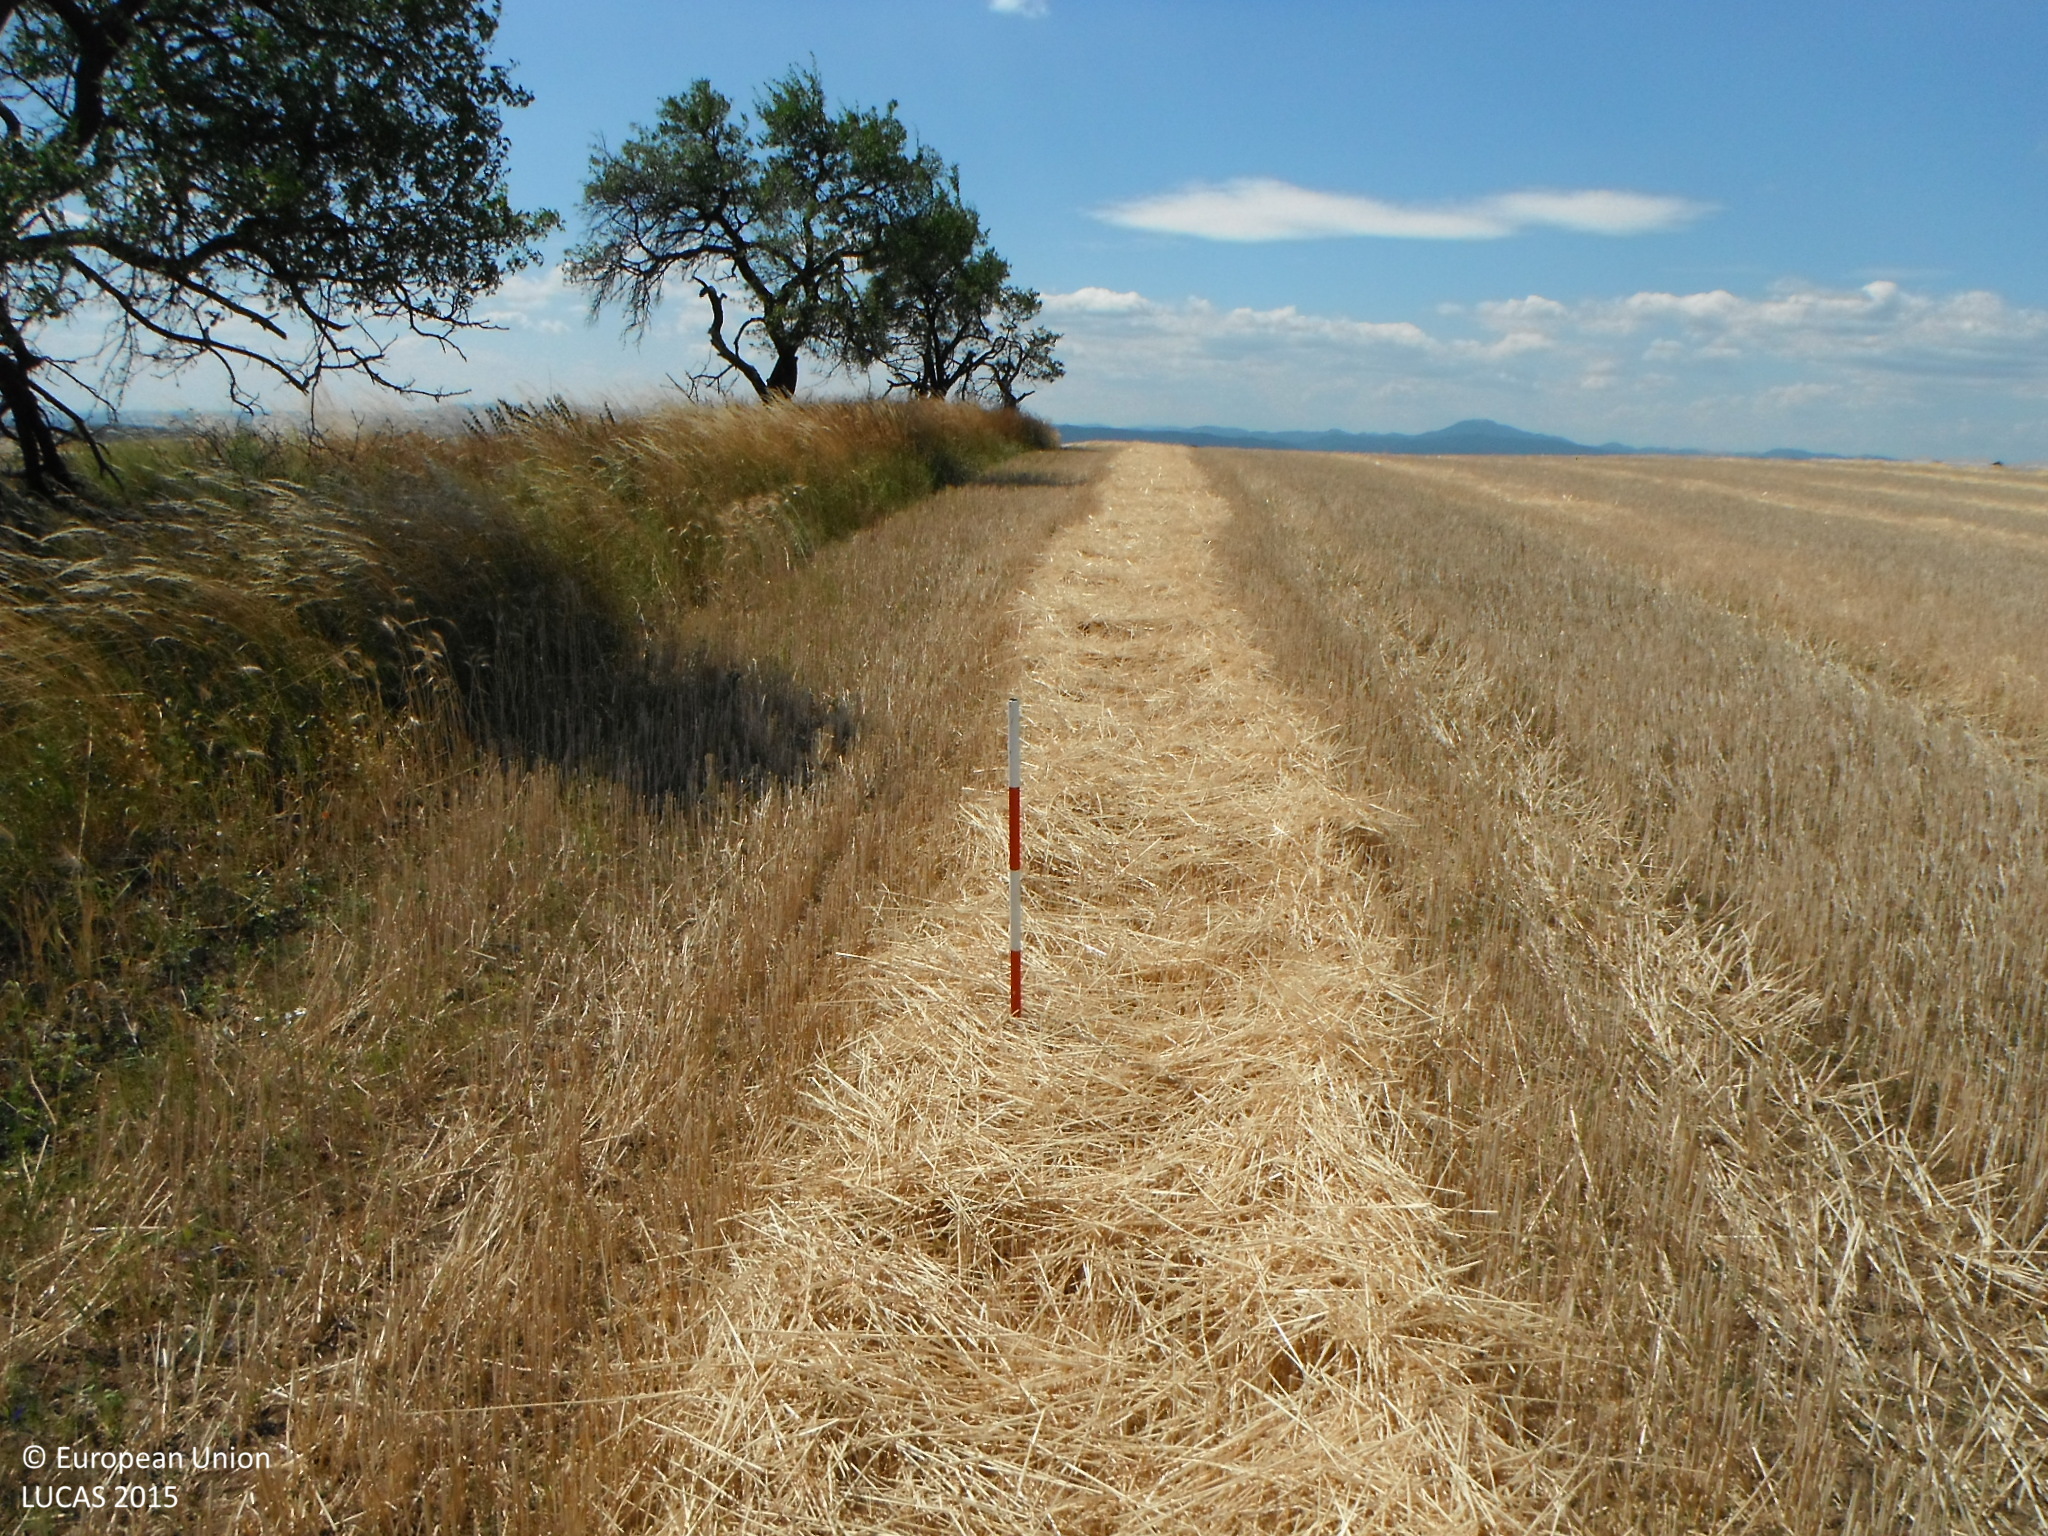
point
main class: Cropland
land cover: Common wheat
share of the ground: > 75 %
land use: Agriculture (excluding fallow land and kitchen gardens)
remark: Harvested field
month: July
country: SK
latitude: 48.3109
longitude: 19.1769
